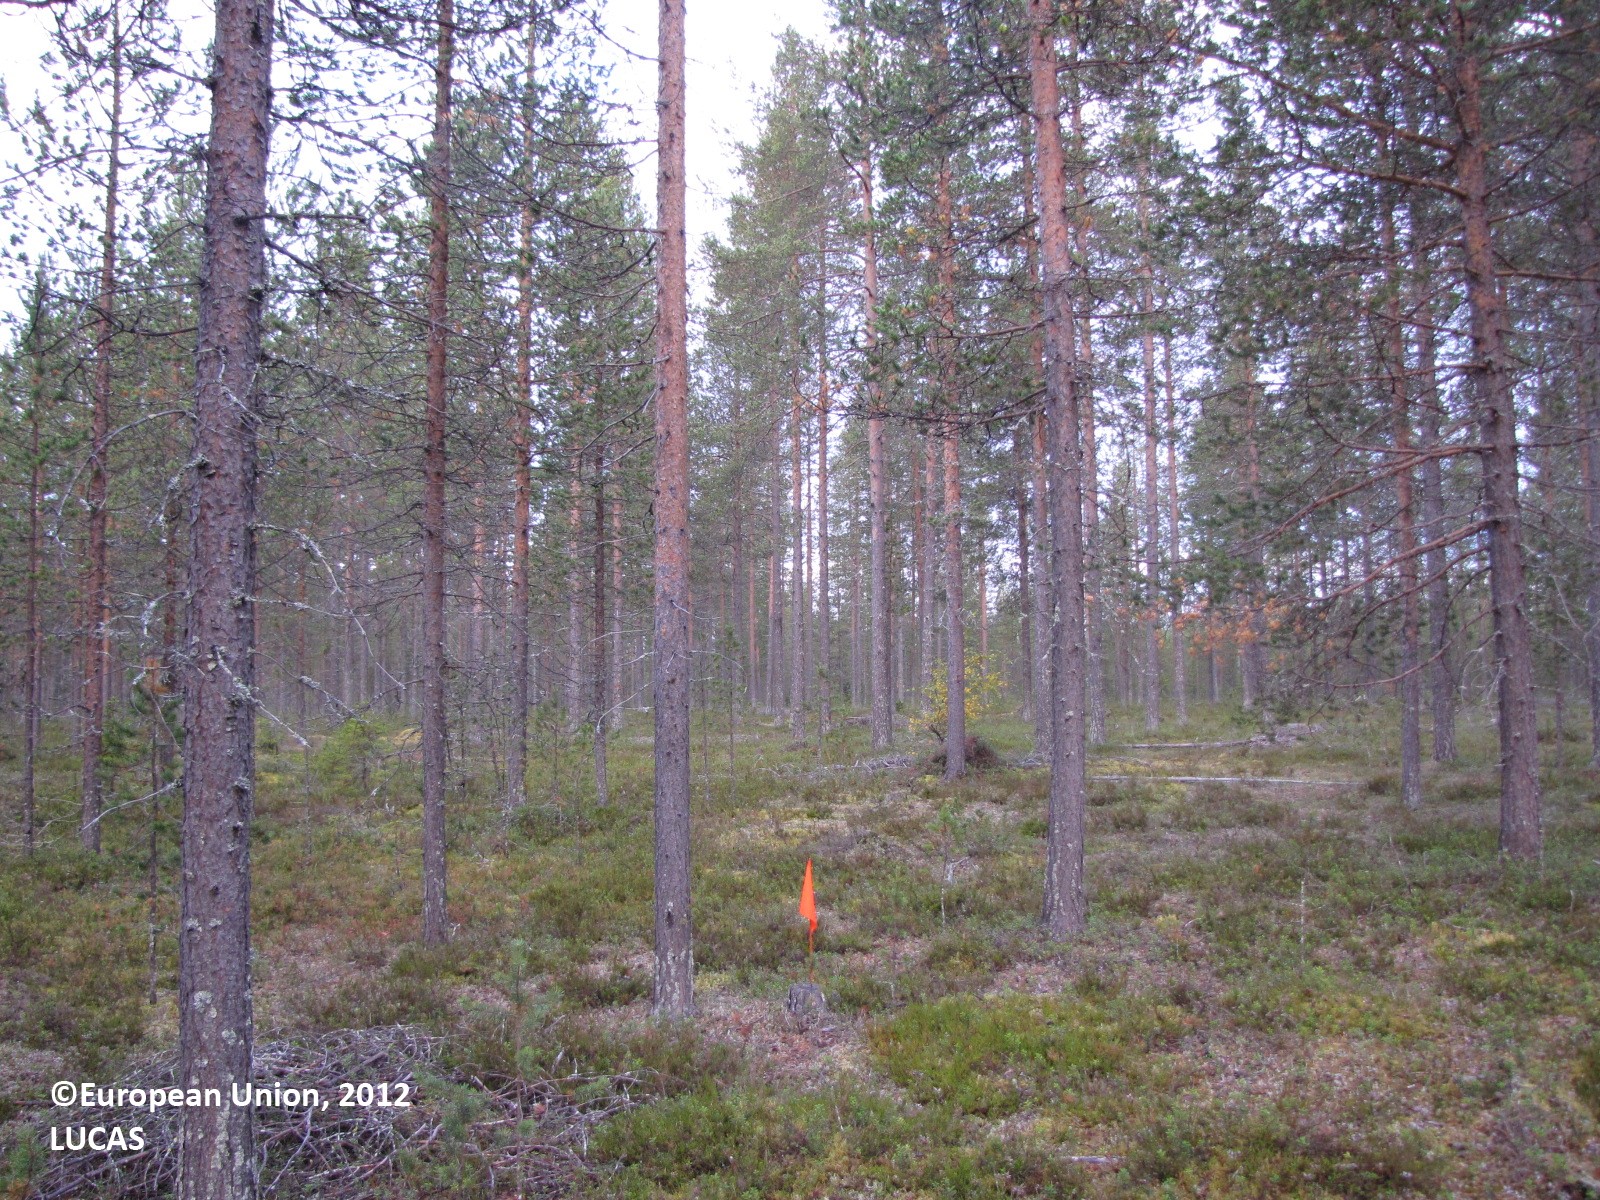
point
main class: Woodland
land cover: Pine dominated coniferous woodland
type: boreal forest
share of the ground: 50 - 75 %
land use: Forestry
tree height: > 5 m
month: September
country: FI
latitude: 67.3139
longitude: 24.8870
